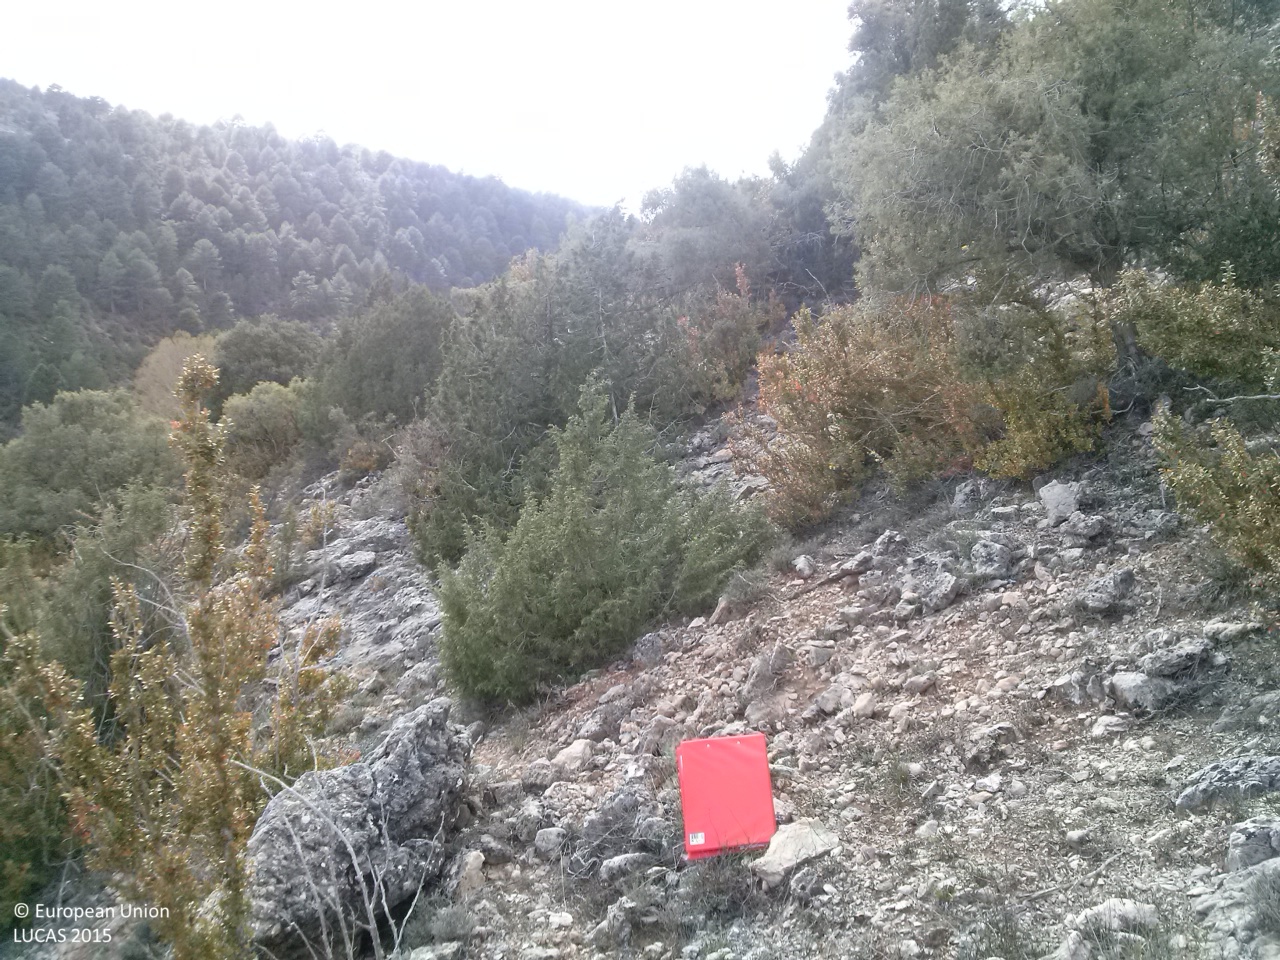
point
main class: Shrubland
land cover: Shrubland with sparse tree cover
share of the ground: 25 - 50 %
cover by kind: consolidated bare surface 50 %, shrubs 35 %, herbaceous plants 10 %, coniferous forest trees 5 %
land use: Agriculture (excluding fallow land and kitchen gardens)
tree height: < 5 m
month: April
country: ES
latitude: 40.1499
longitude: -1.6932
